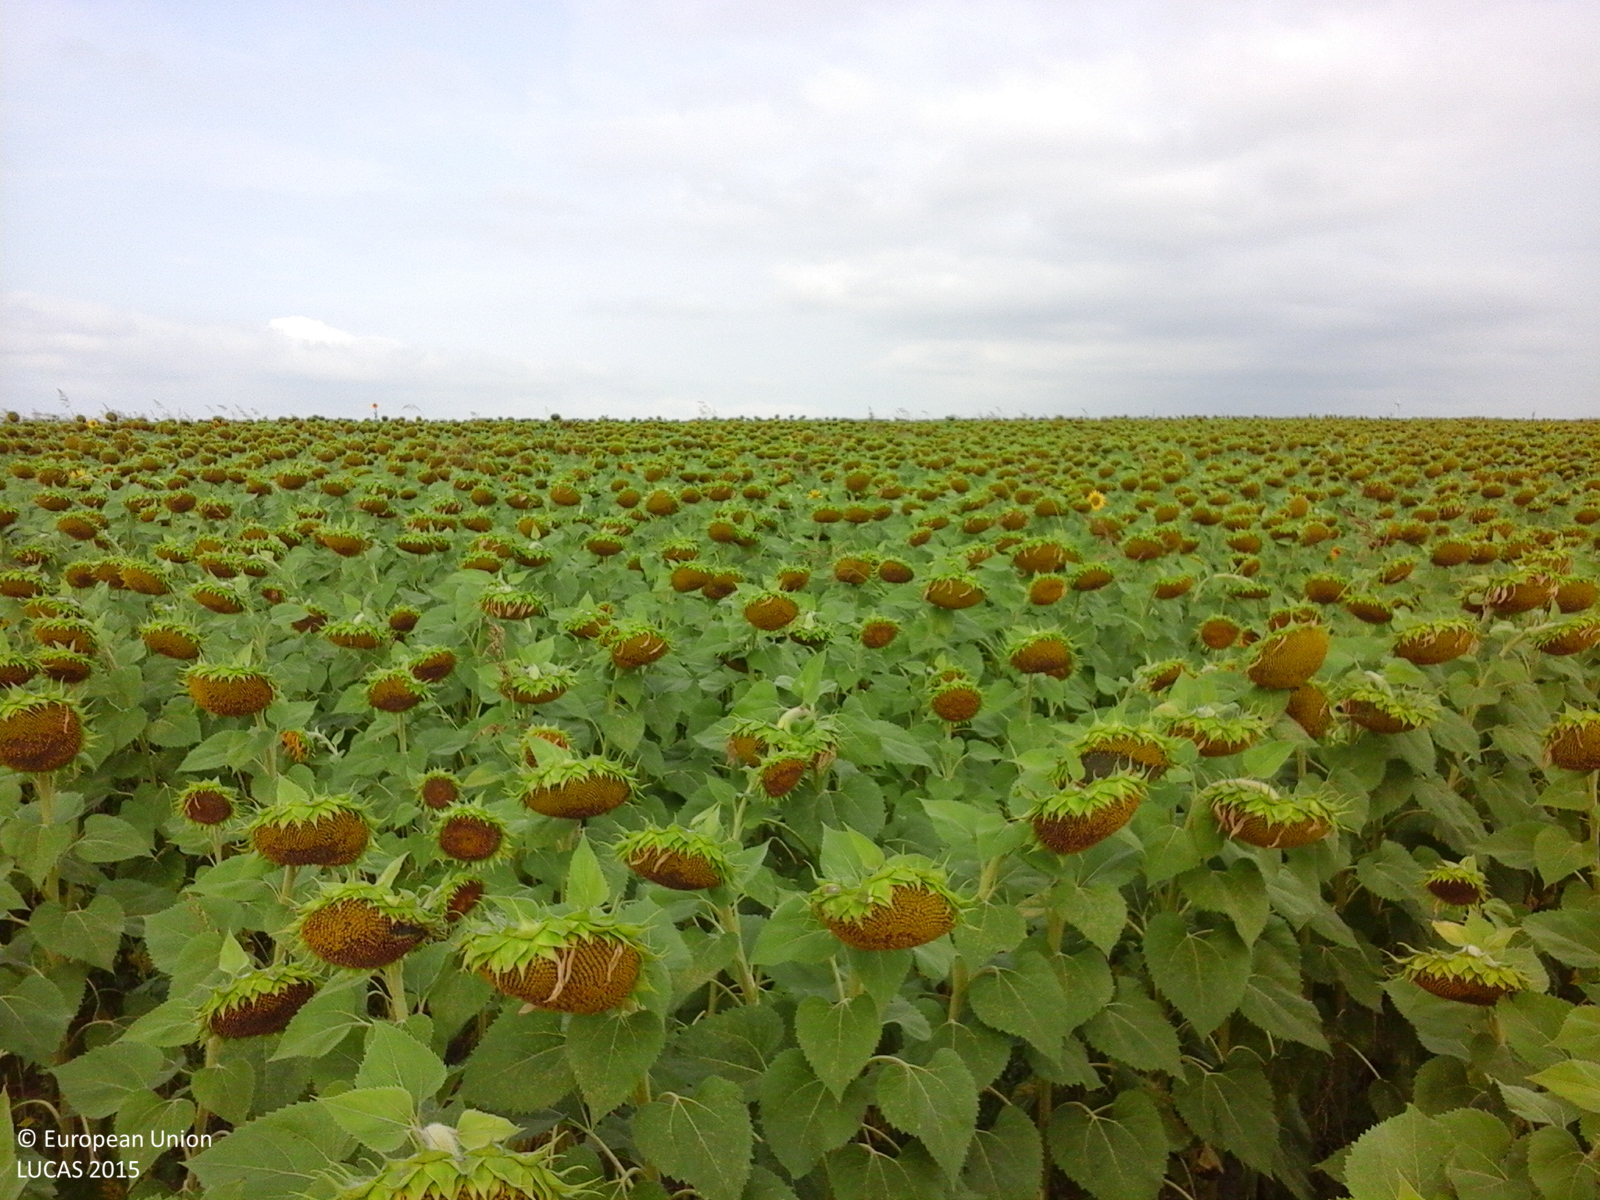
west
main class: Cropland
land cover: Sunflower
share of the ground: > 75 %
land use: Agriculture (excluding fallow land and kitchen gardens)
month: August
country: RO
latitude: 44.7370
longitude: 28.6046
